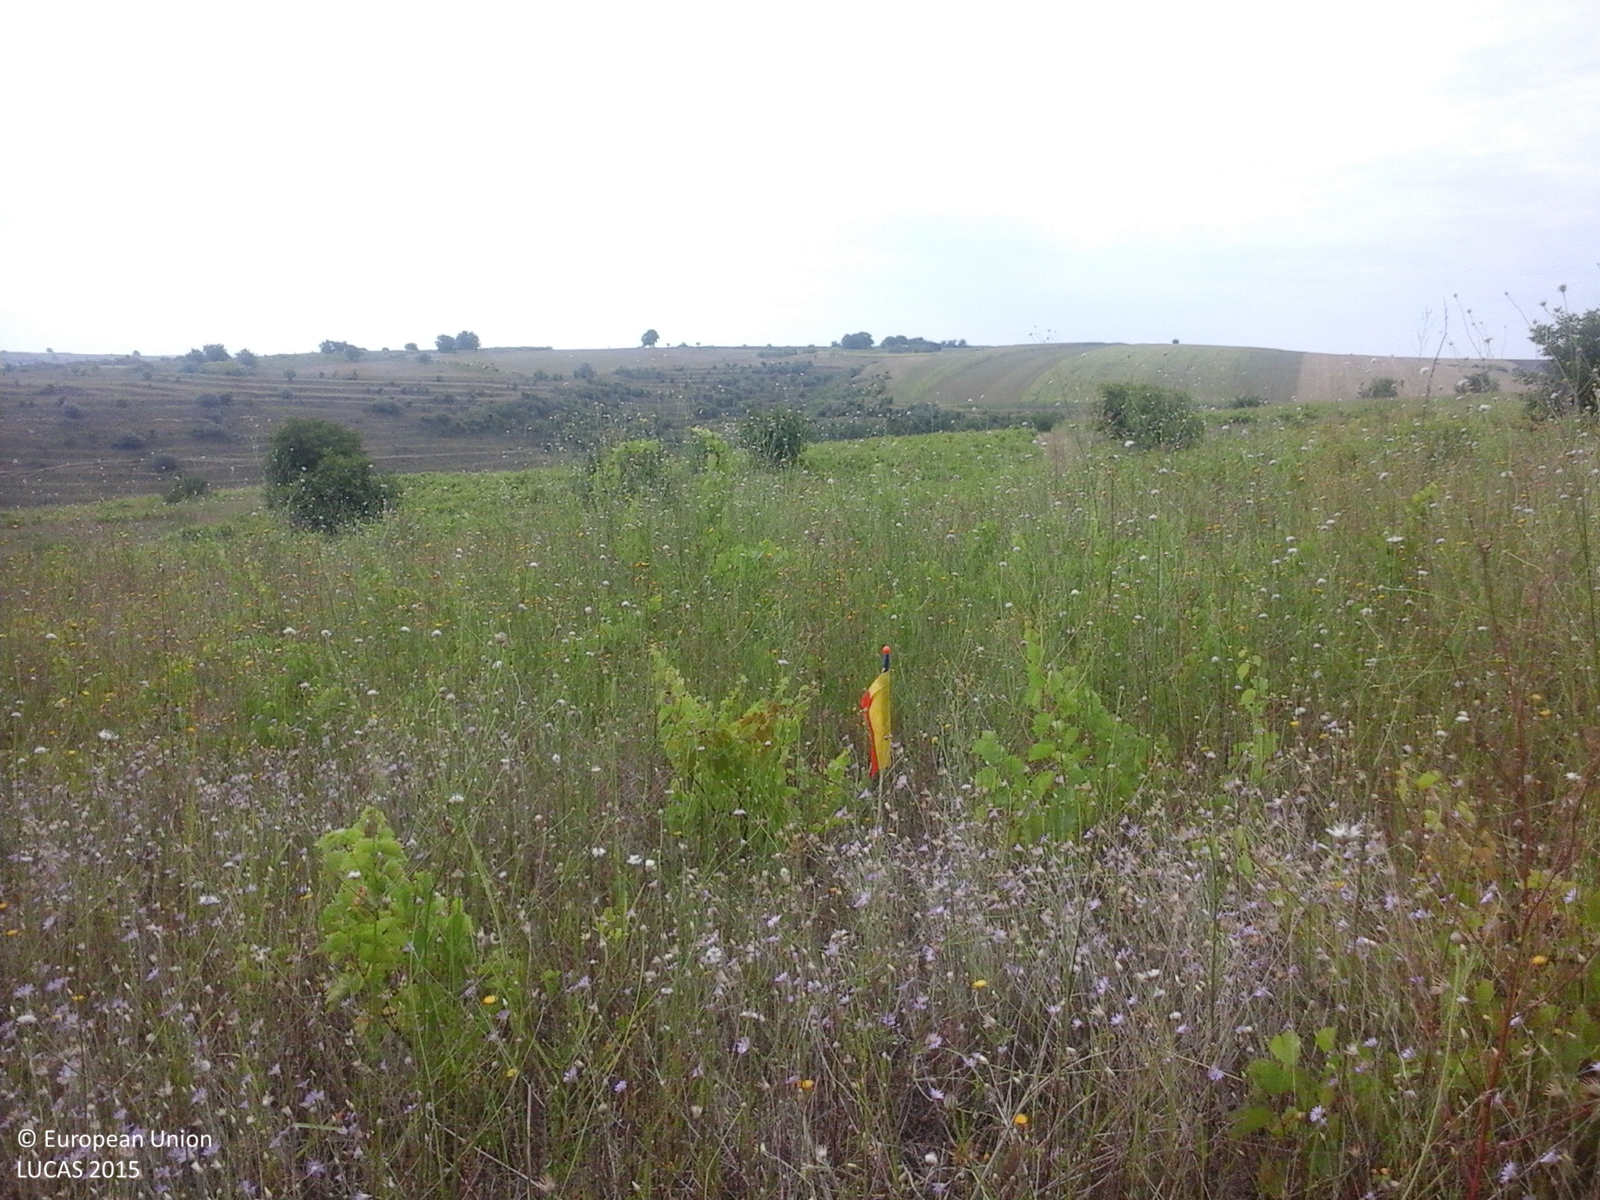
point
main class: Cropland
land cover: Vineyards
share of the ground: 25 - 50 %
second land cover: Spontaneously vegetated surfaces
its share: > 75 %
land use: Agriculture (excluding fallow land and kitchen gardens)
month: August
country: RO
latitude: 44.0699
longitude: 27.6855
